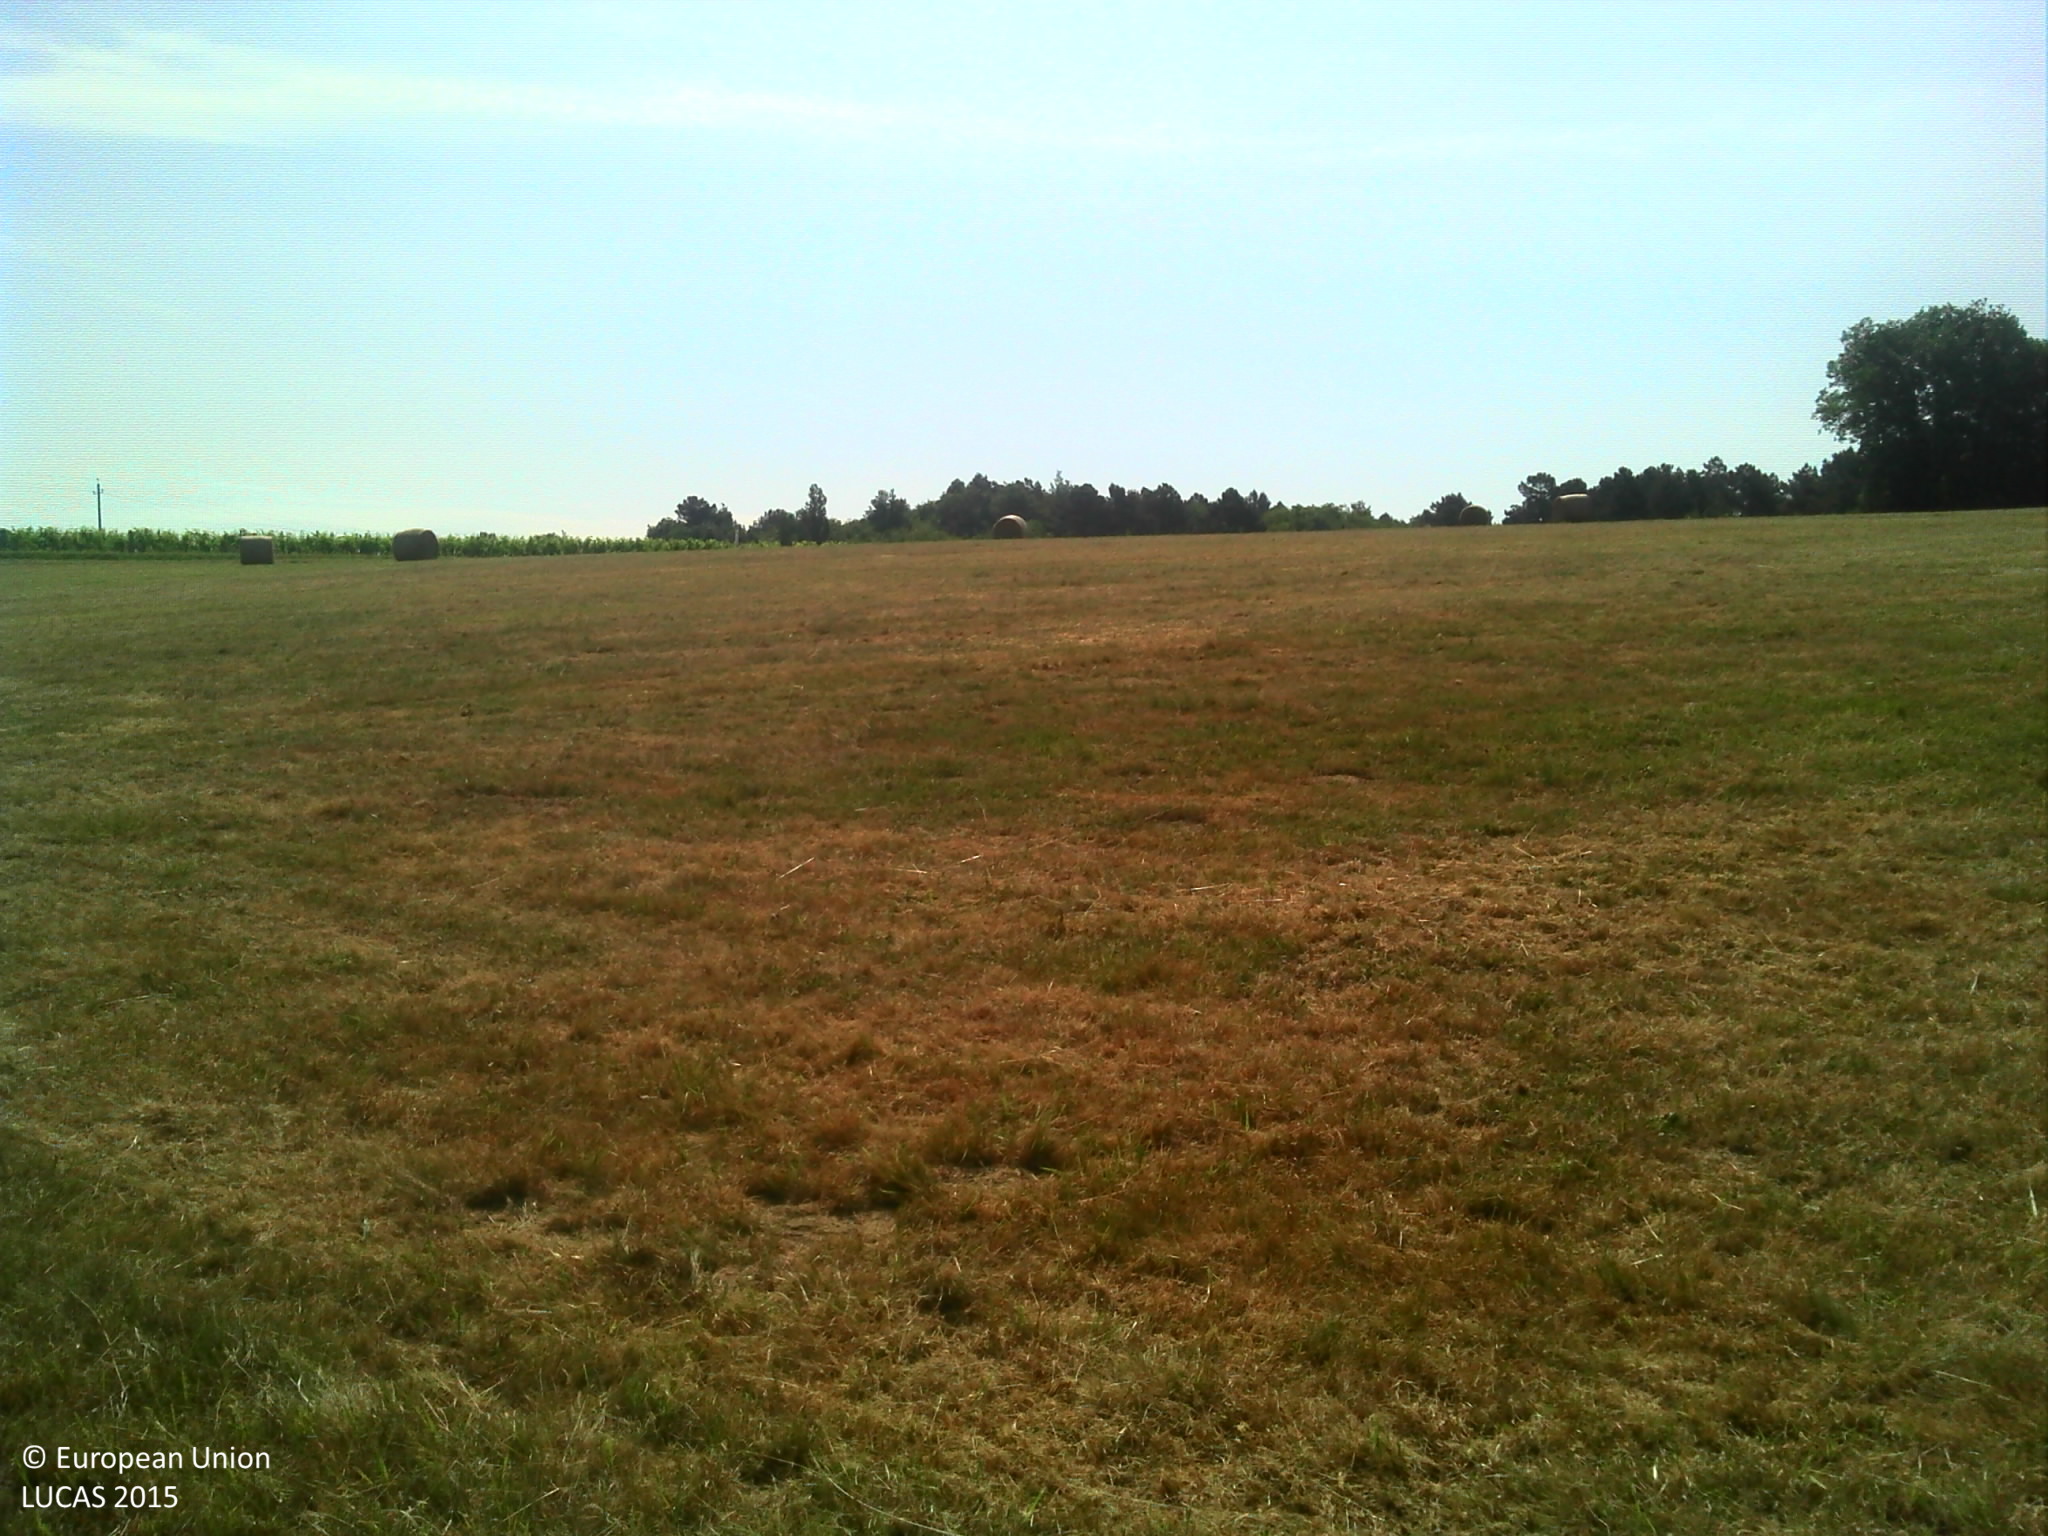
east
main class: Grassland
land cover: Grassland without tree/shrub cover
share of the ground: > 75 %
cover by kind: herbaceous plants 100 %
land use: Agriculture (excluding fallow land and kitchen gardens)
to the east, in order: Grassland without tree/shrub cover; Ditches and canals; Grass margins; Paved roads, cycling and walking lanes; Grass margins; Ditches and canals; Grass margins; Vineyards; Grassland without tree/shrub cover; Electric lines; Grassland without tree/shrub cover; Grassland with sparse tree/shrub cover; Tracks; Grassland without tree/shrub cover
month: June
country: FR
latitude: 43.9624
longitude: 1.6890
